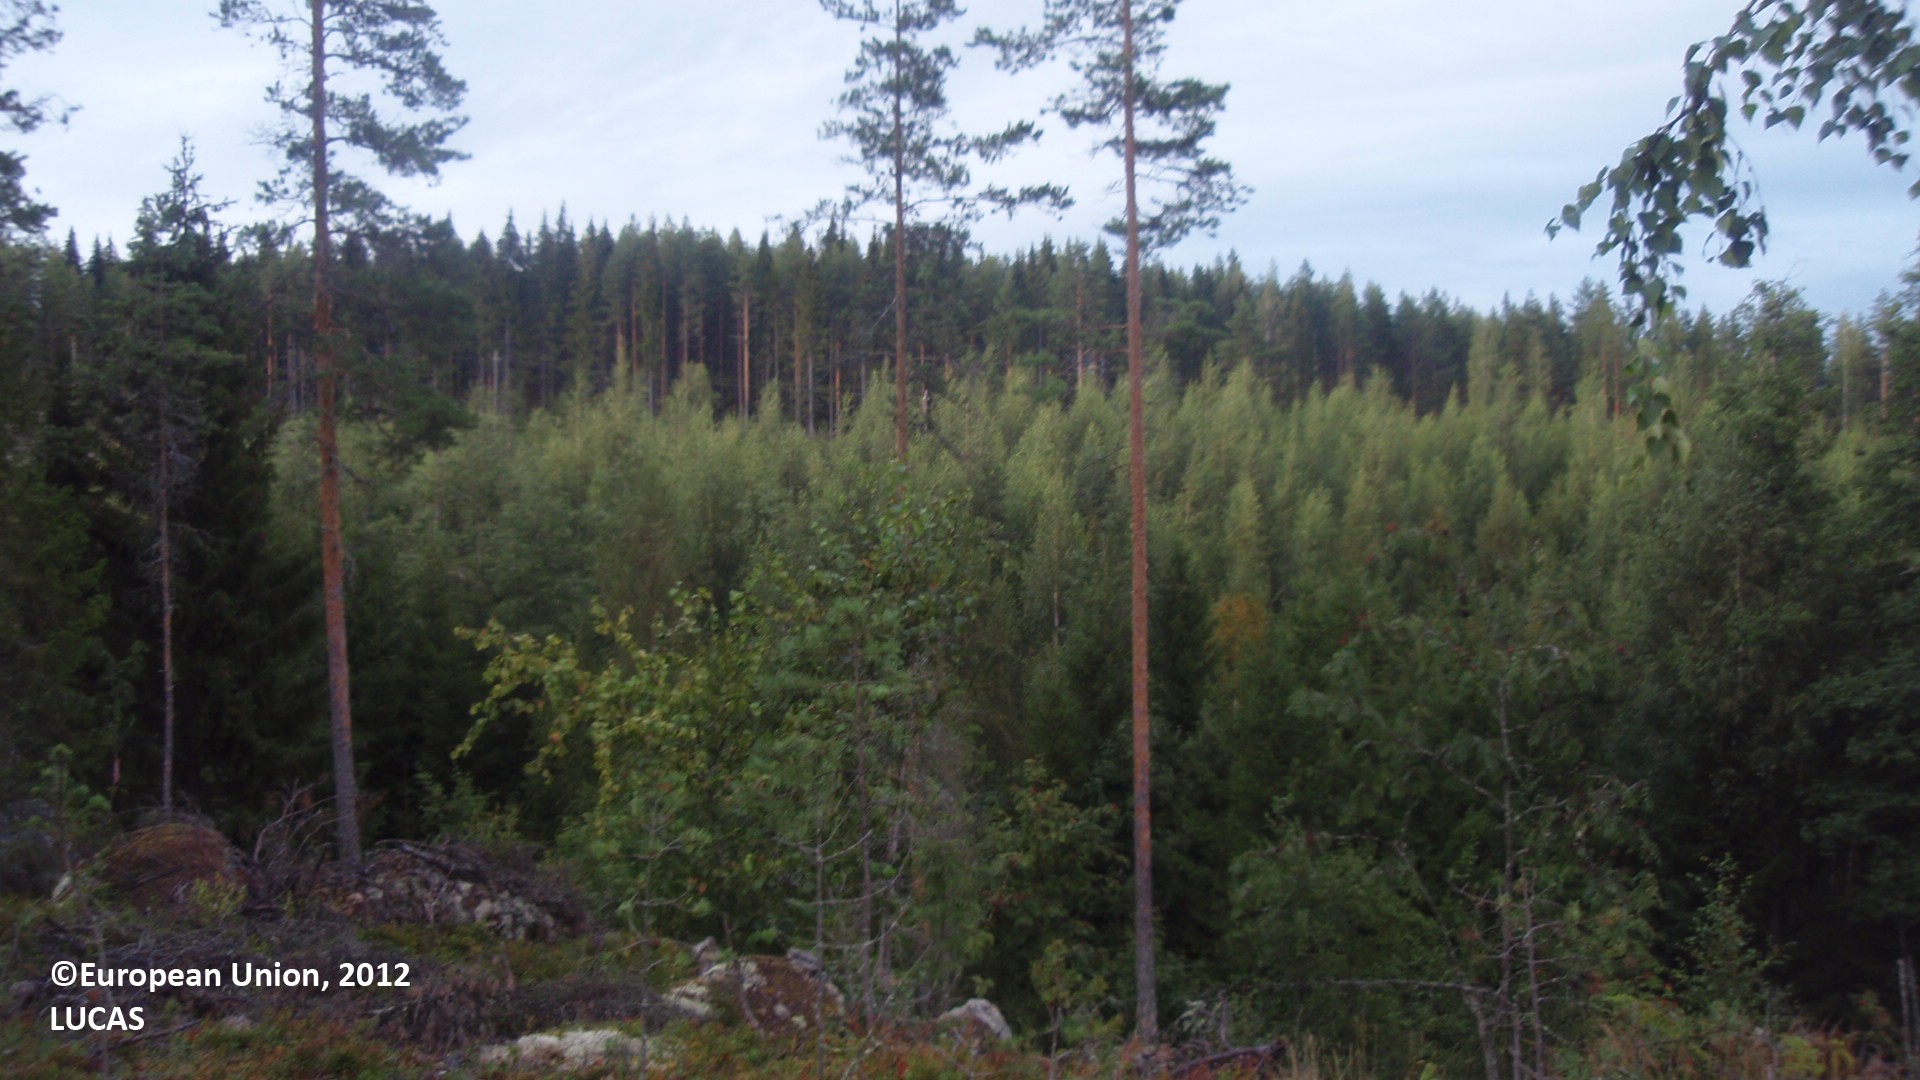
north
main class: Shrubland
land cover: Shrubland with sparse tree cover
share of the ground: > 75 %
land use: Forestry
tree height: > 5 m
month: August
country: FI
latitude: 61.5880
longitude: 27.8410
